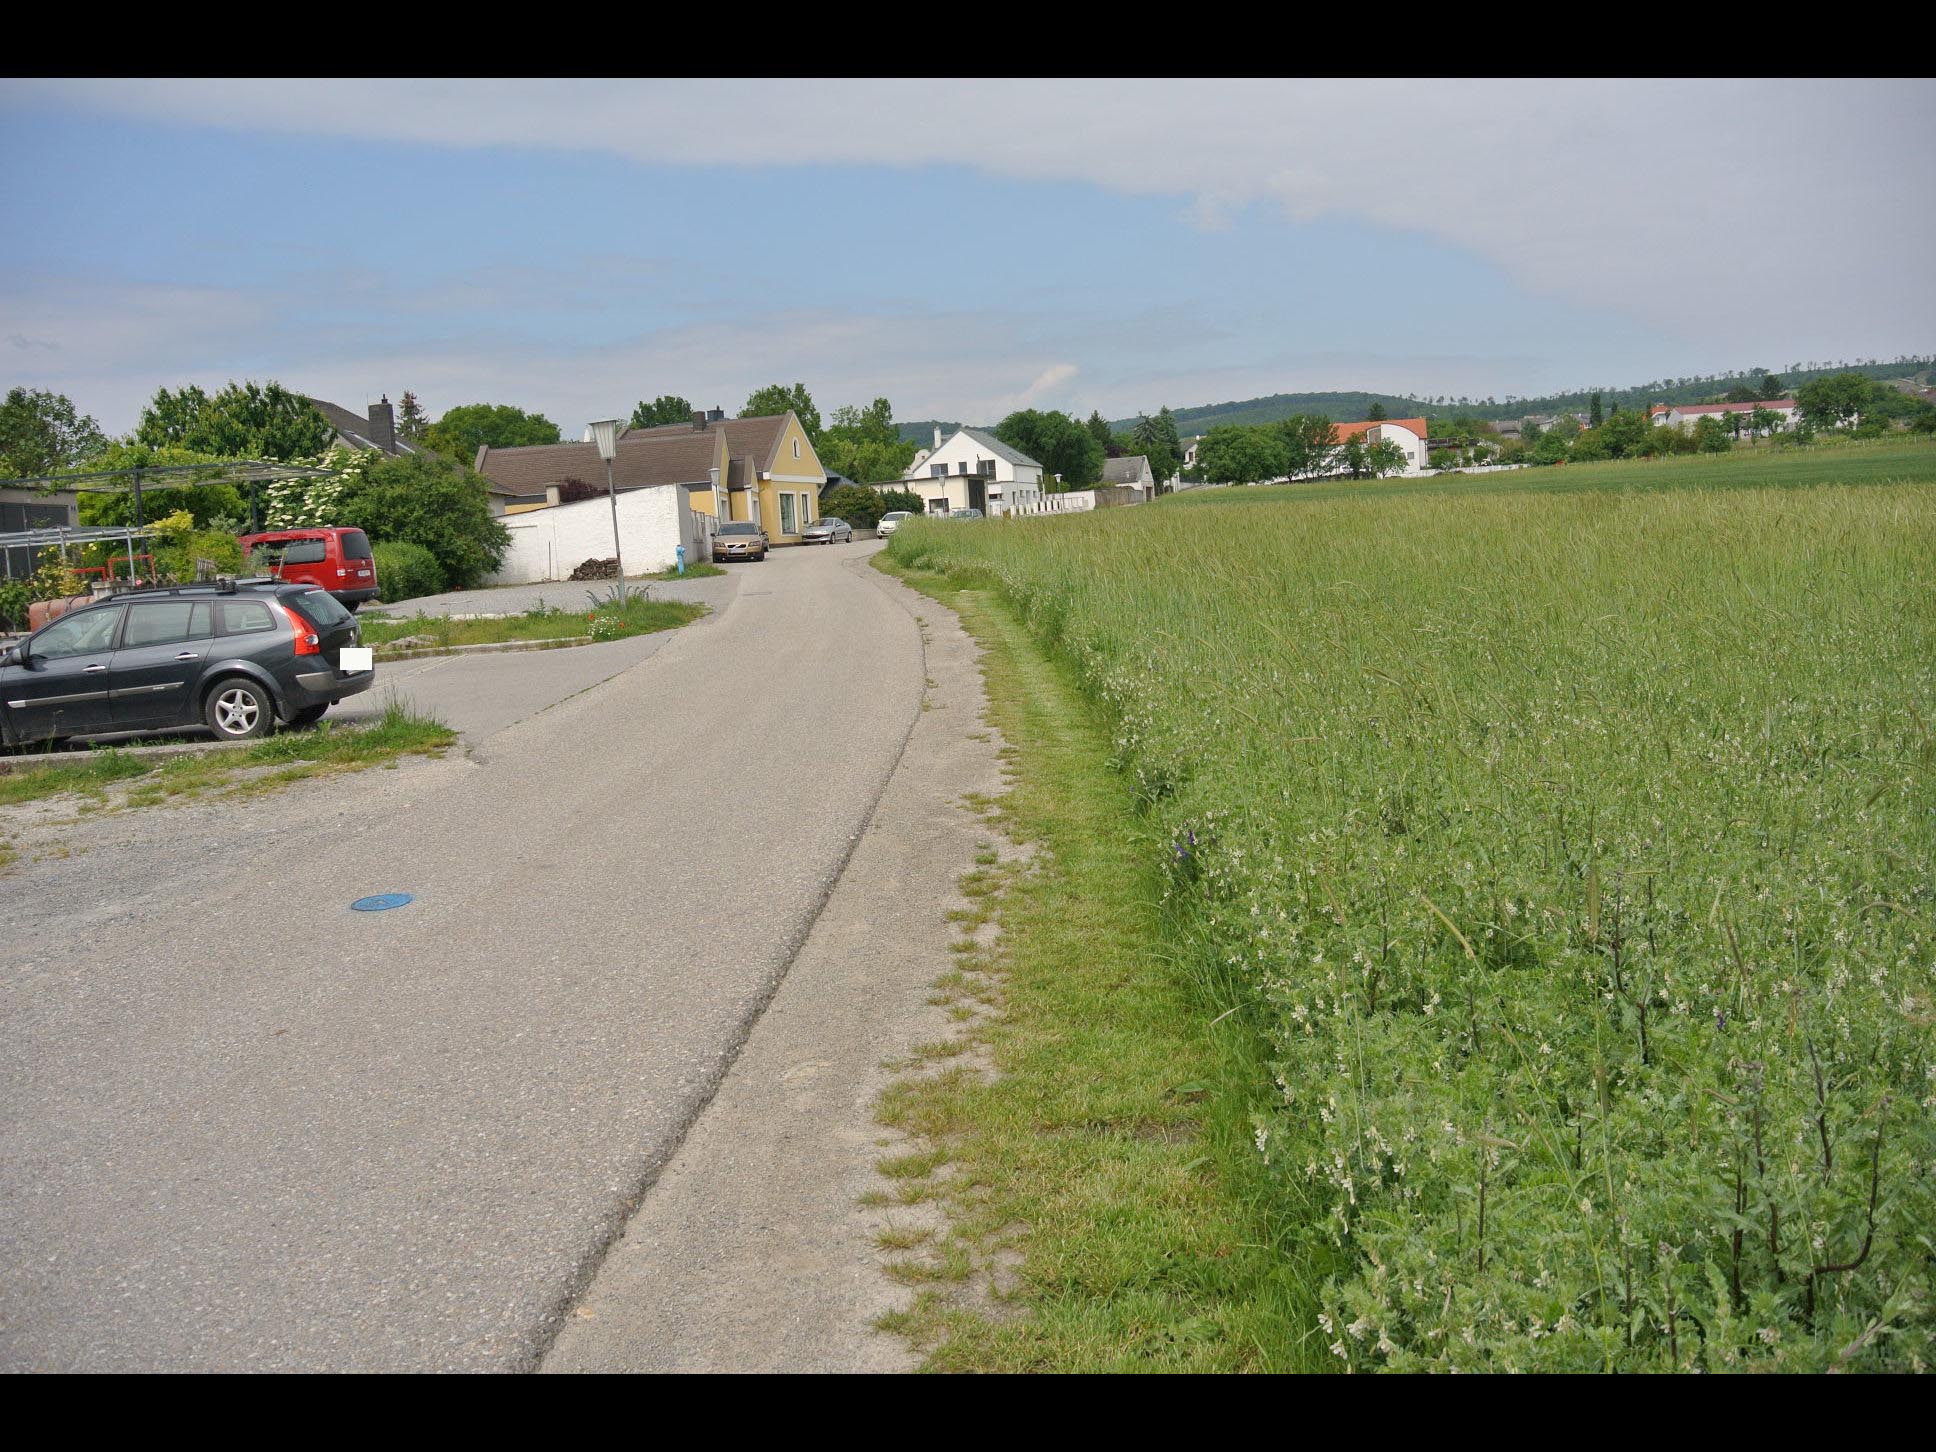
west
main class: Cropland
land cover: Other leguminous and mixtures for fodder
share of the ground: > 75 %
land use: Agriculture (excluding fallow land and kitchen gardens)
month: May
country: AT
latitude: 47.9450
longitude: 16.7402
